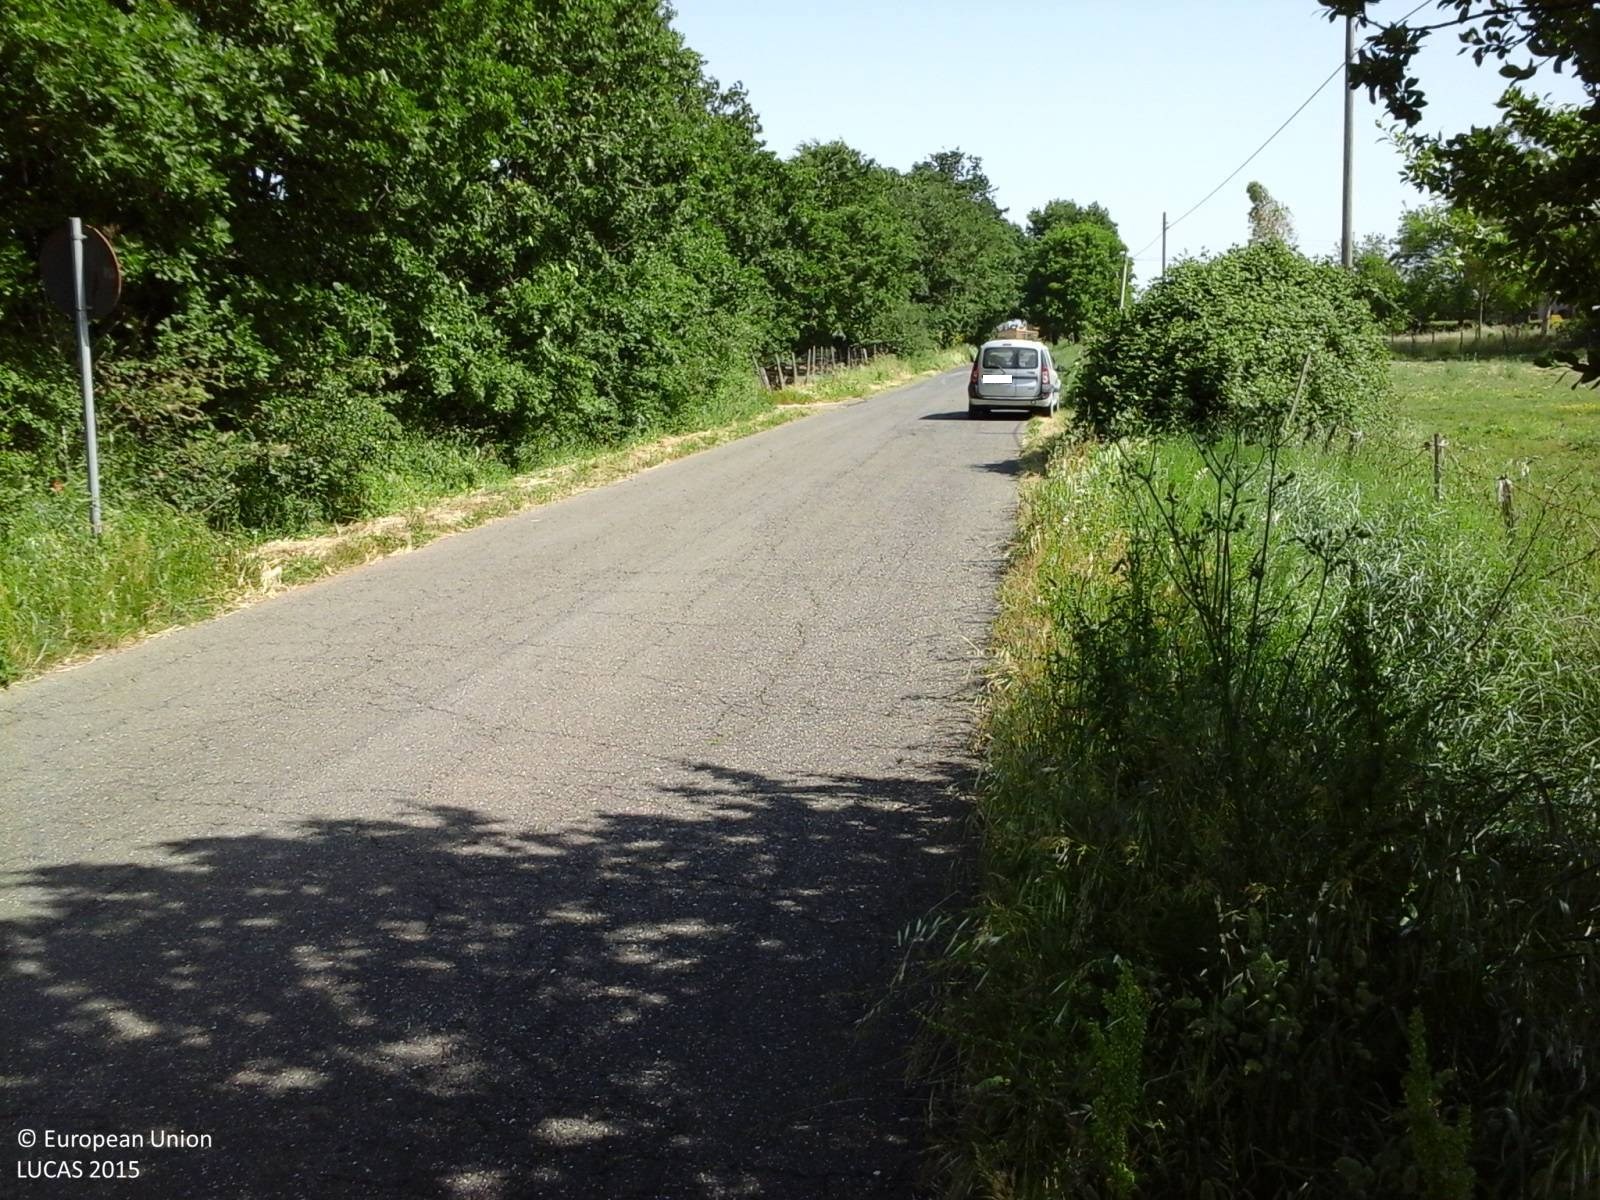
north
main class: Grassland
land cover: Grassland without tree/shrub cover
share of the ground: > 75 %
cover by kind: herbaceous plants 100 %
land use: Agriculture (excluding fallow land and kitchen gardens)
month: May
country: IT
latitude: 42.3096
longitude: 11.9706
